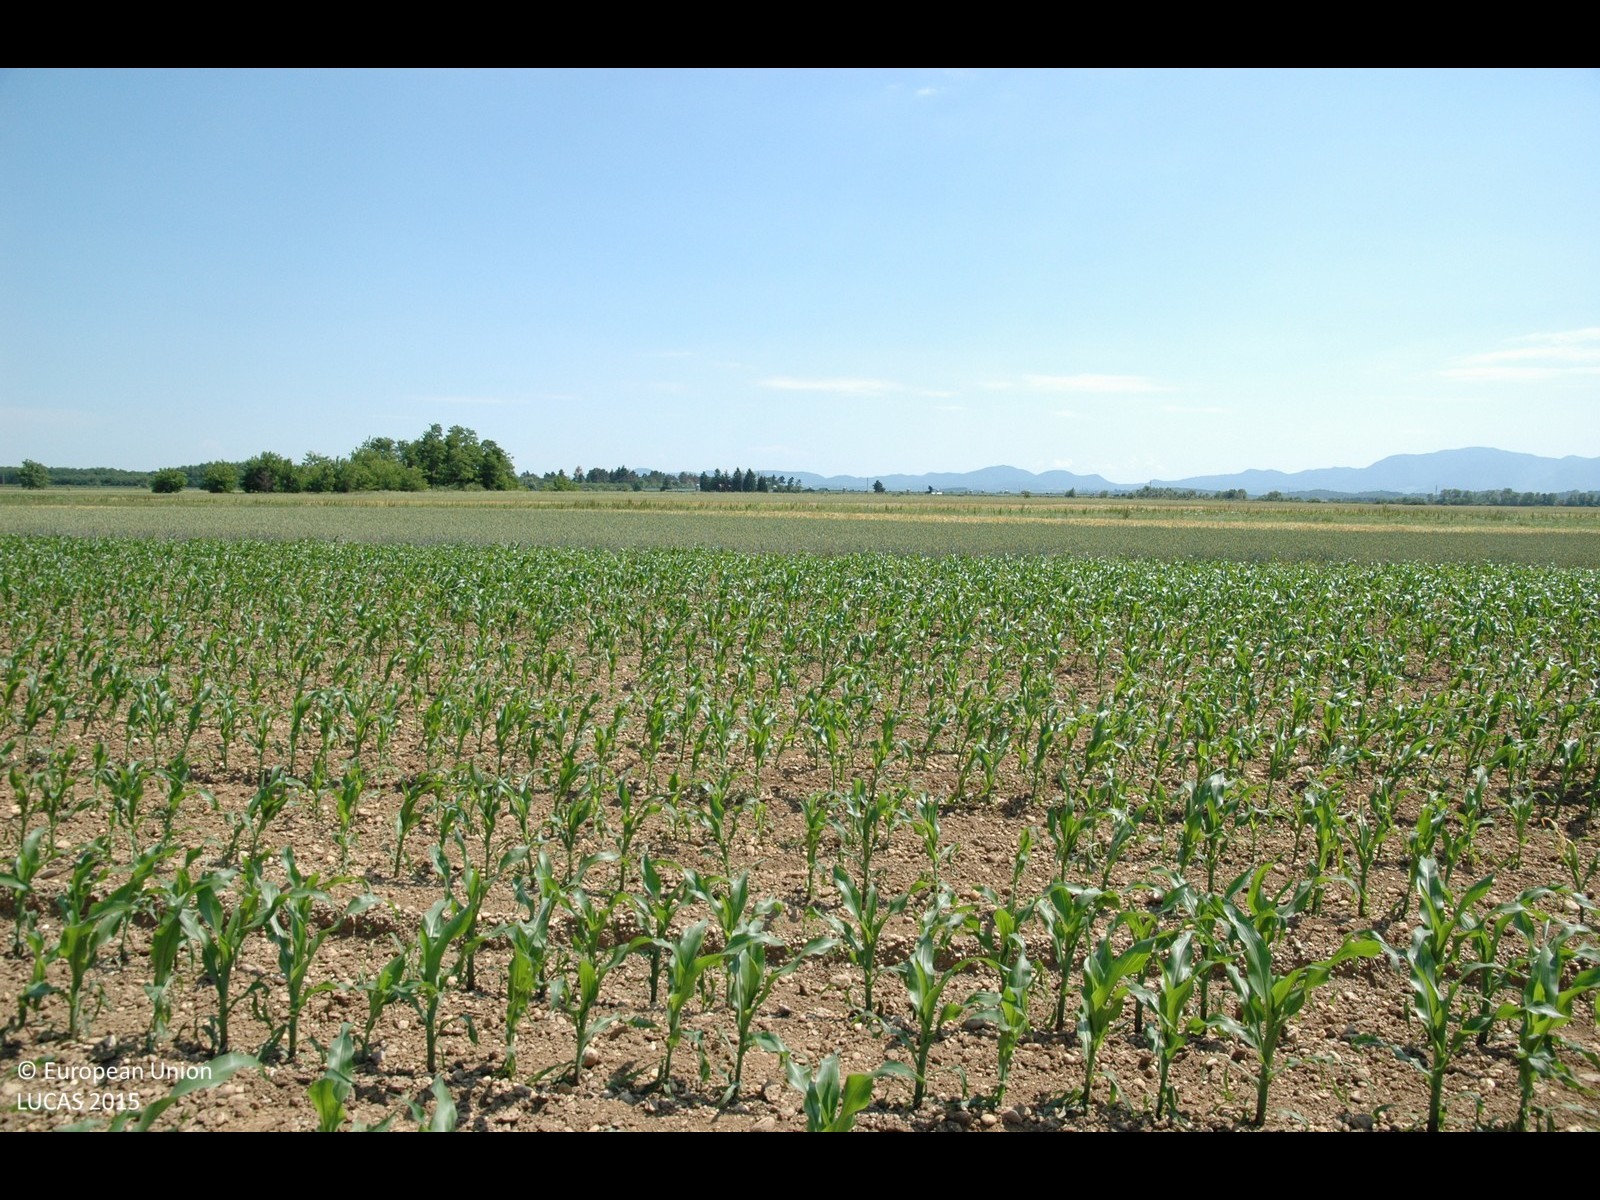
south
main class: Cropland
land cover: Maize
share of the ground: 25 - 50 %
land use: Agriculture (excluding fallow land and kitchen gardens)
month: June
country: HR
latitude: 46.3535
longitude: 16.1726
